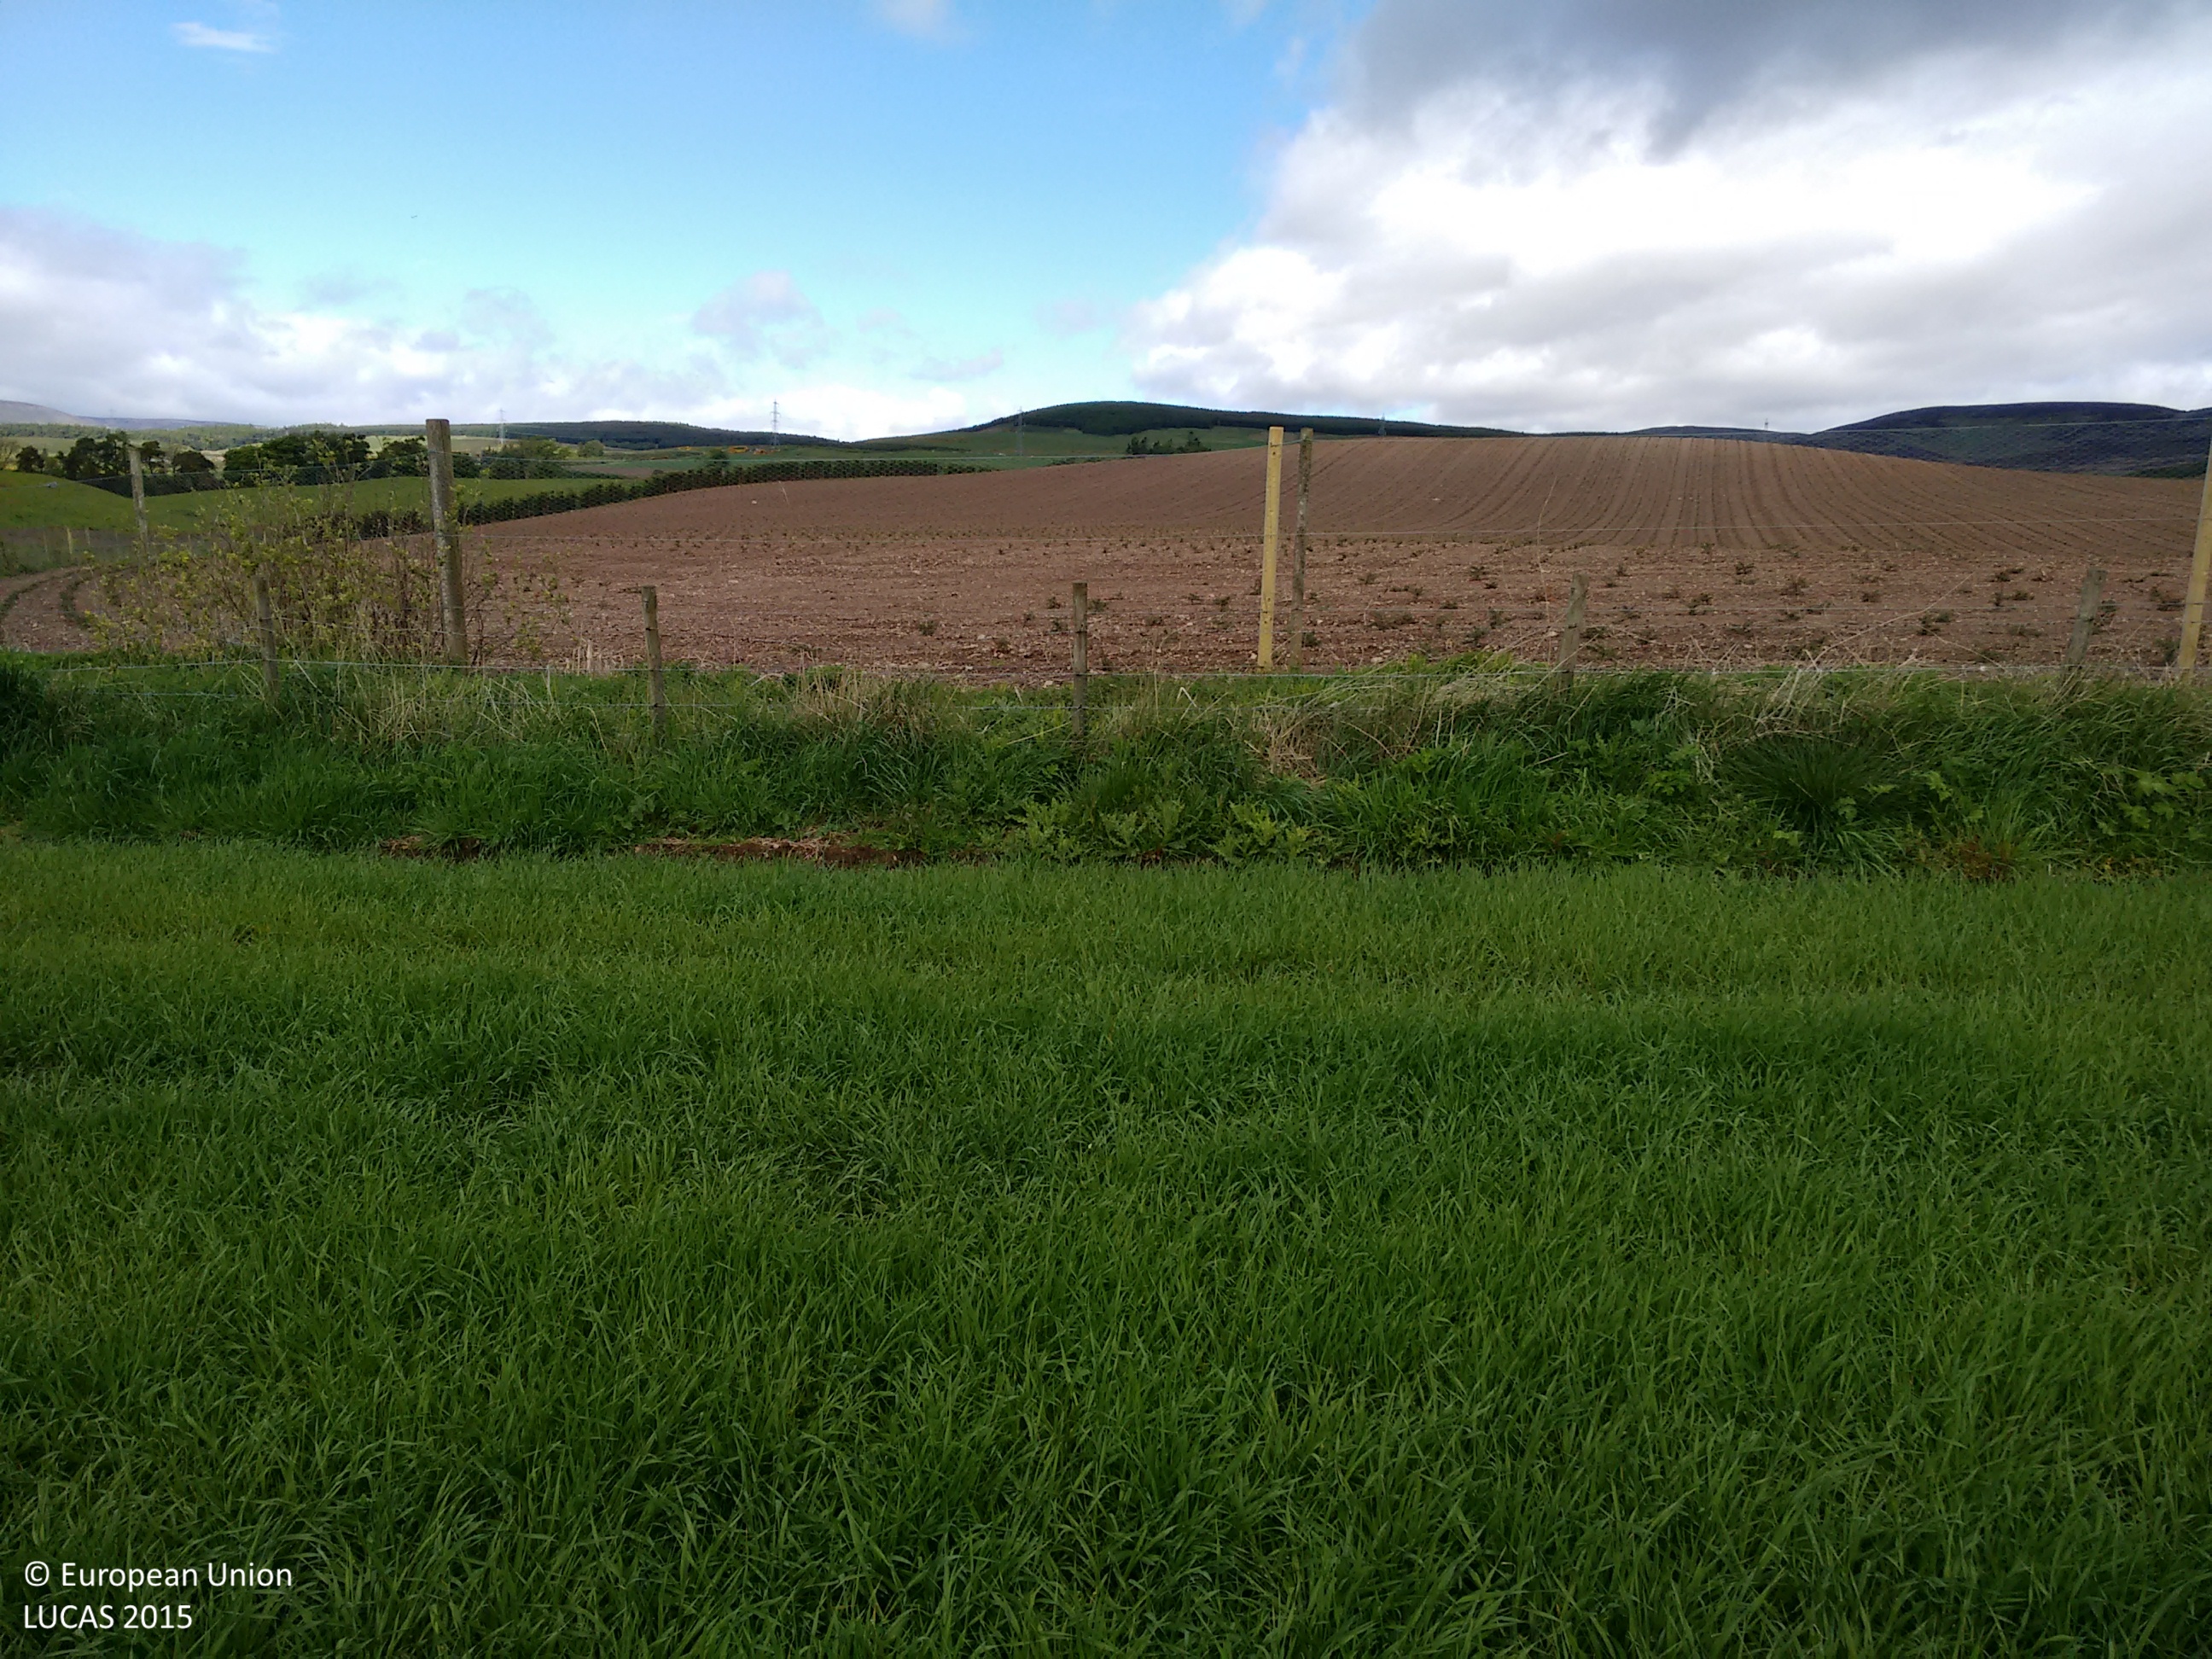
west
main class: Cropland
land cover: Barley
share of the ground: > 75 %
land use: Agriculture (excluding fallow land and kitchen gardens)
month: June
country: GB
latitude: 56.8573
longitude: -2.6034
